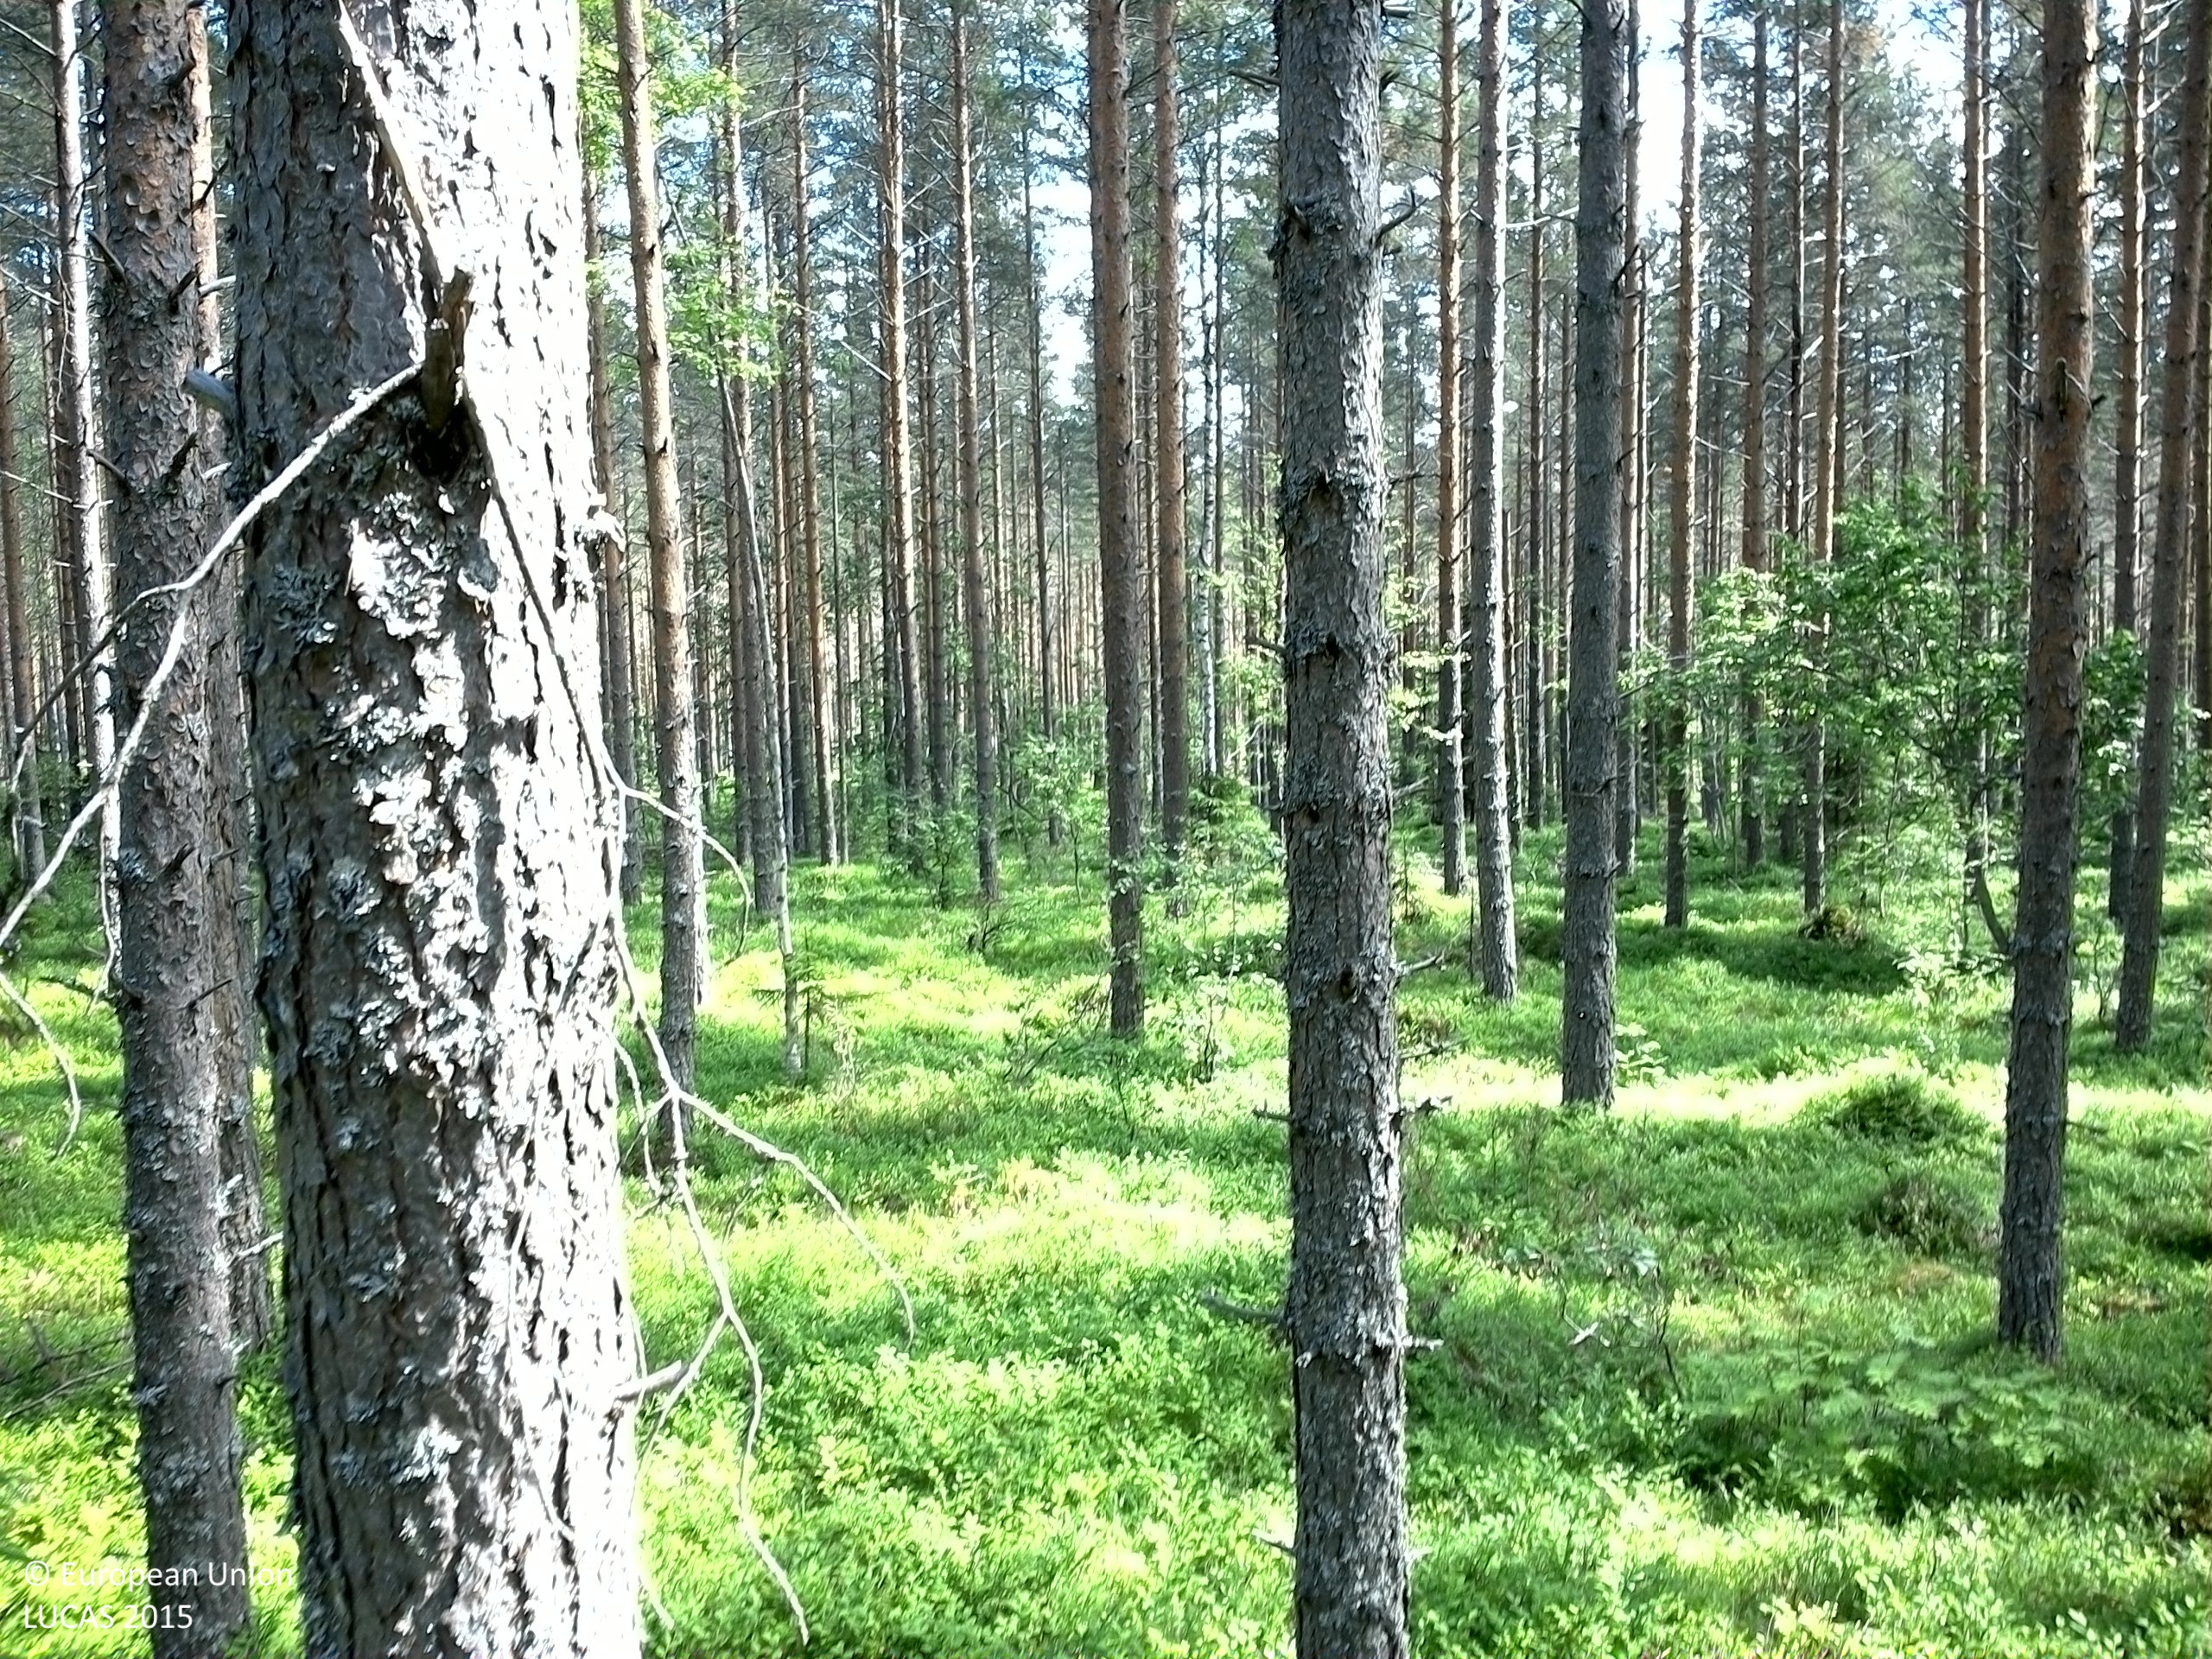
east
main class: Woodland
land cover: Pine dominated coniferous woodland
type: boreal forest
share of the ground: 50 - 75 %
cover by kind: coniferous forest trees 50 %, shrubs 40 %, broadleaved forest trees 10 %
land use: Forestry
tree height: > 5 m
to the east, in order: Pine dominated coniferous woodland; Spruce dominated mixed woodland
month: July
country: SE
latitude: 63.4992
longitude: 18.4728
